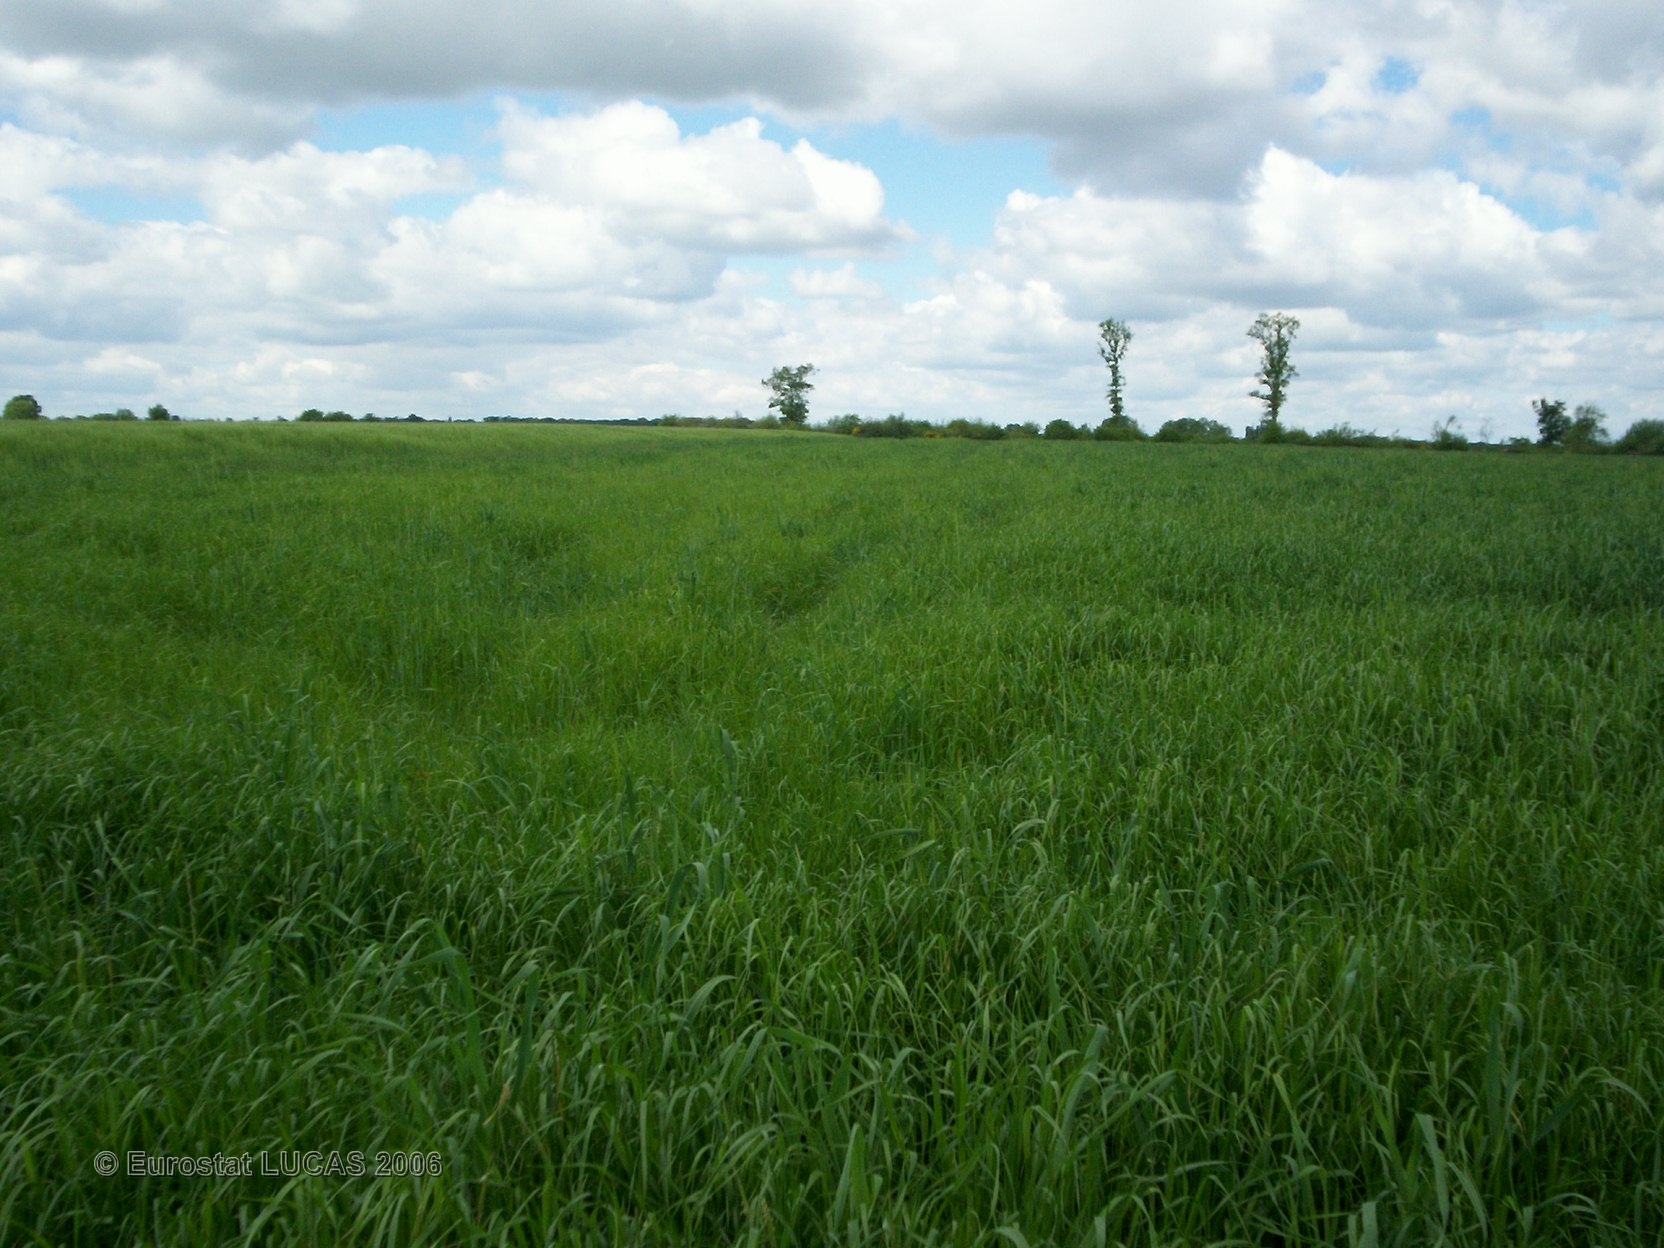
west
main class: Grassland
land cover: Grassland without tree/shrub cover
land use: Agriculture (excluding fallow land and kitchen gardens)
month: May
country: FR
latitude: 47.1362
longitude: -0.3515
